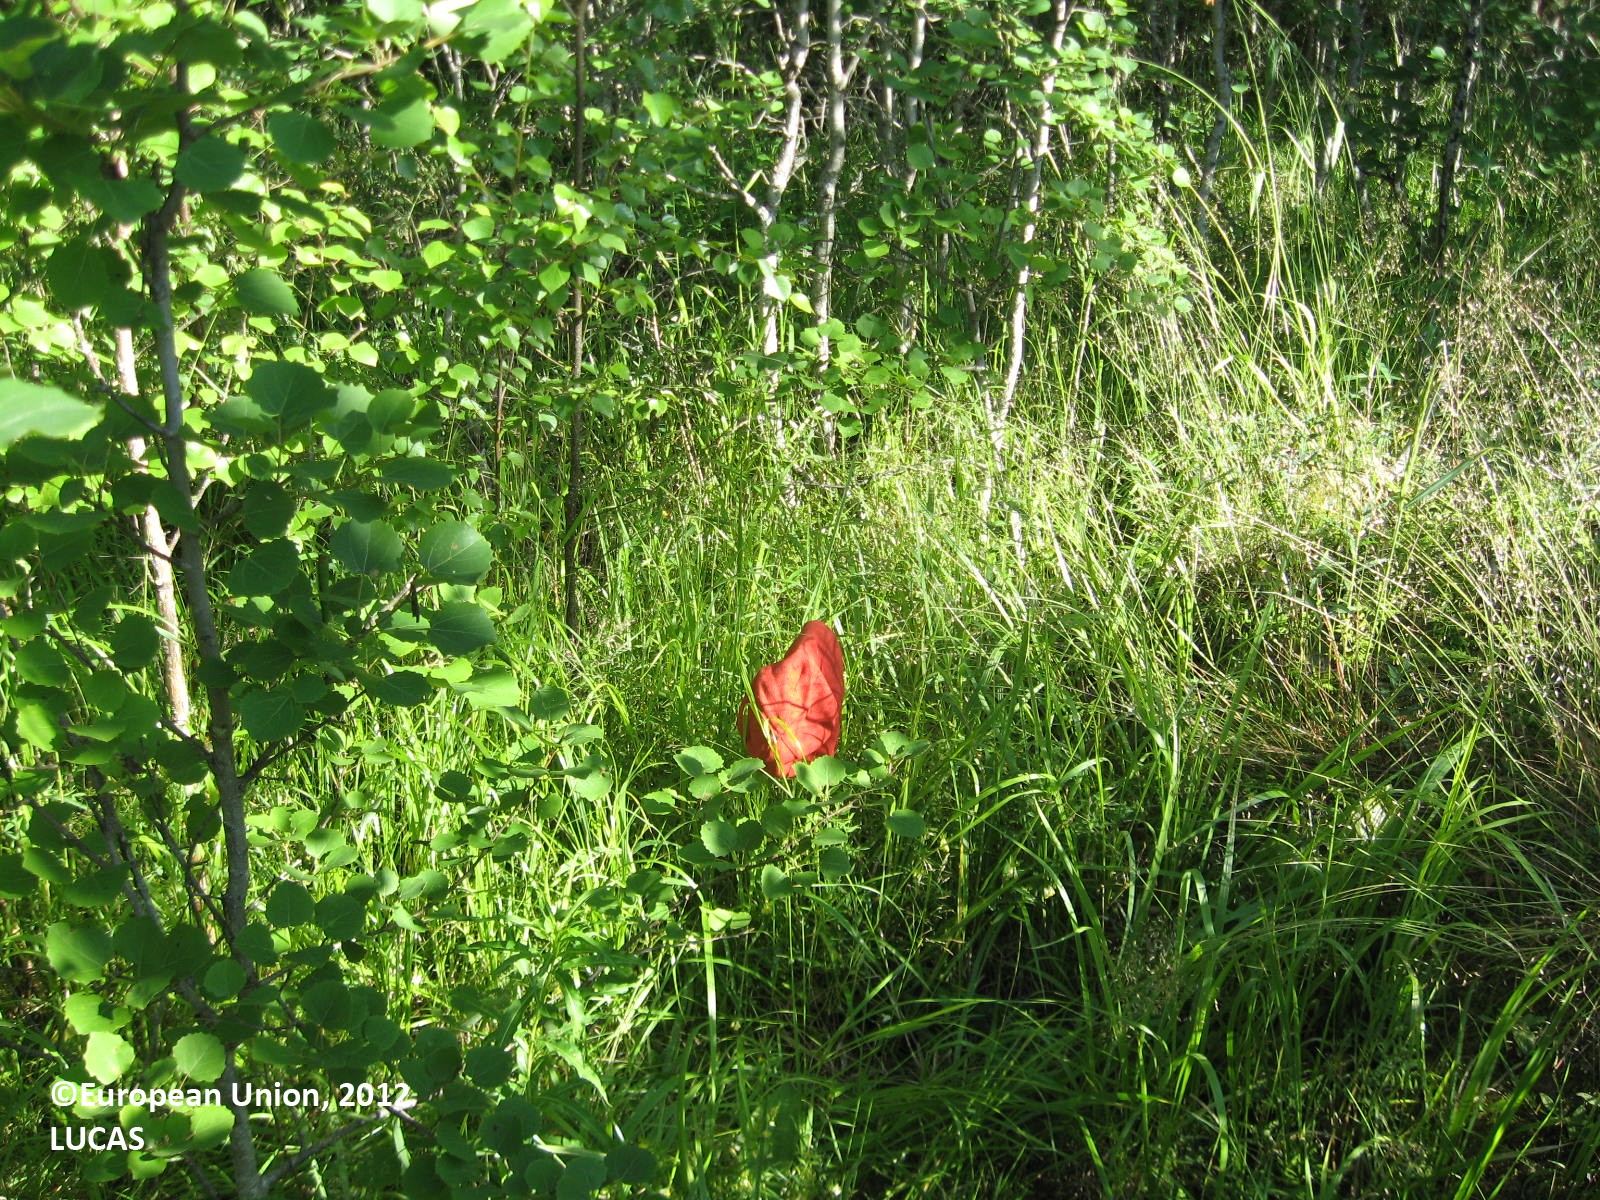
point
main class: Woodland
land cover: Broadleaved woodland
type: boreal forest
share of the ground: > 75 %
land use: Forestry
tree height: > 5 m
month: July
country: FI
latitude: 62.1400
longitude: 21.4199
